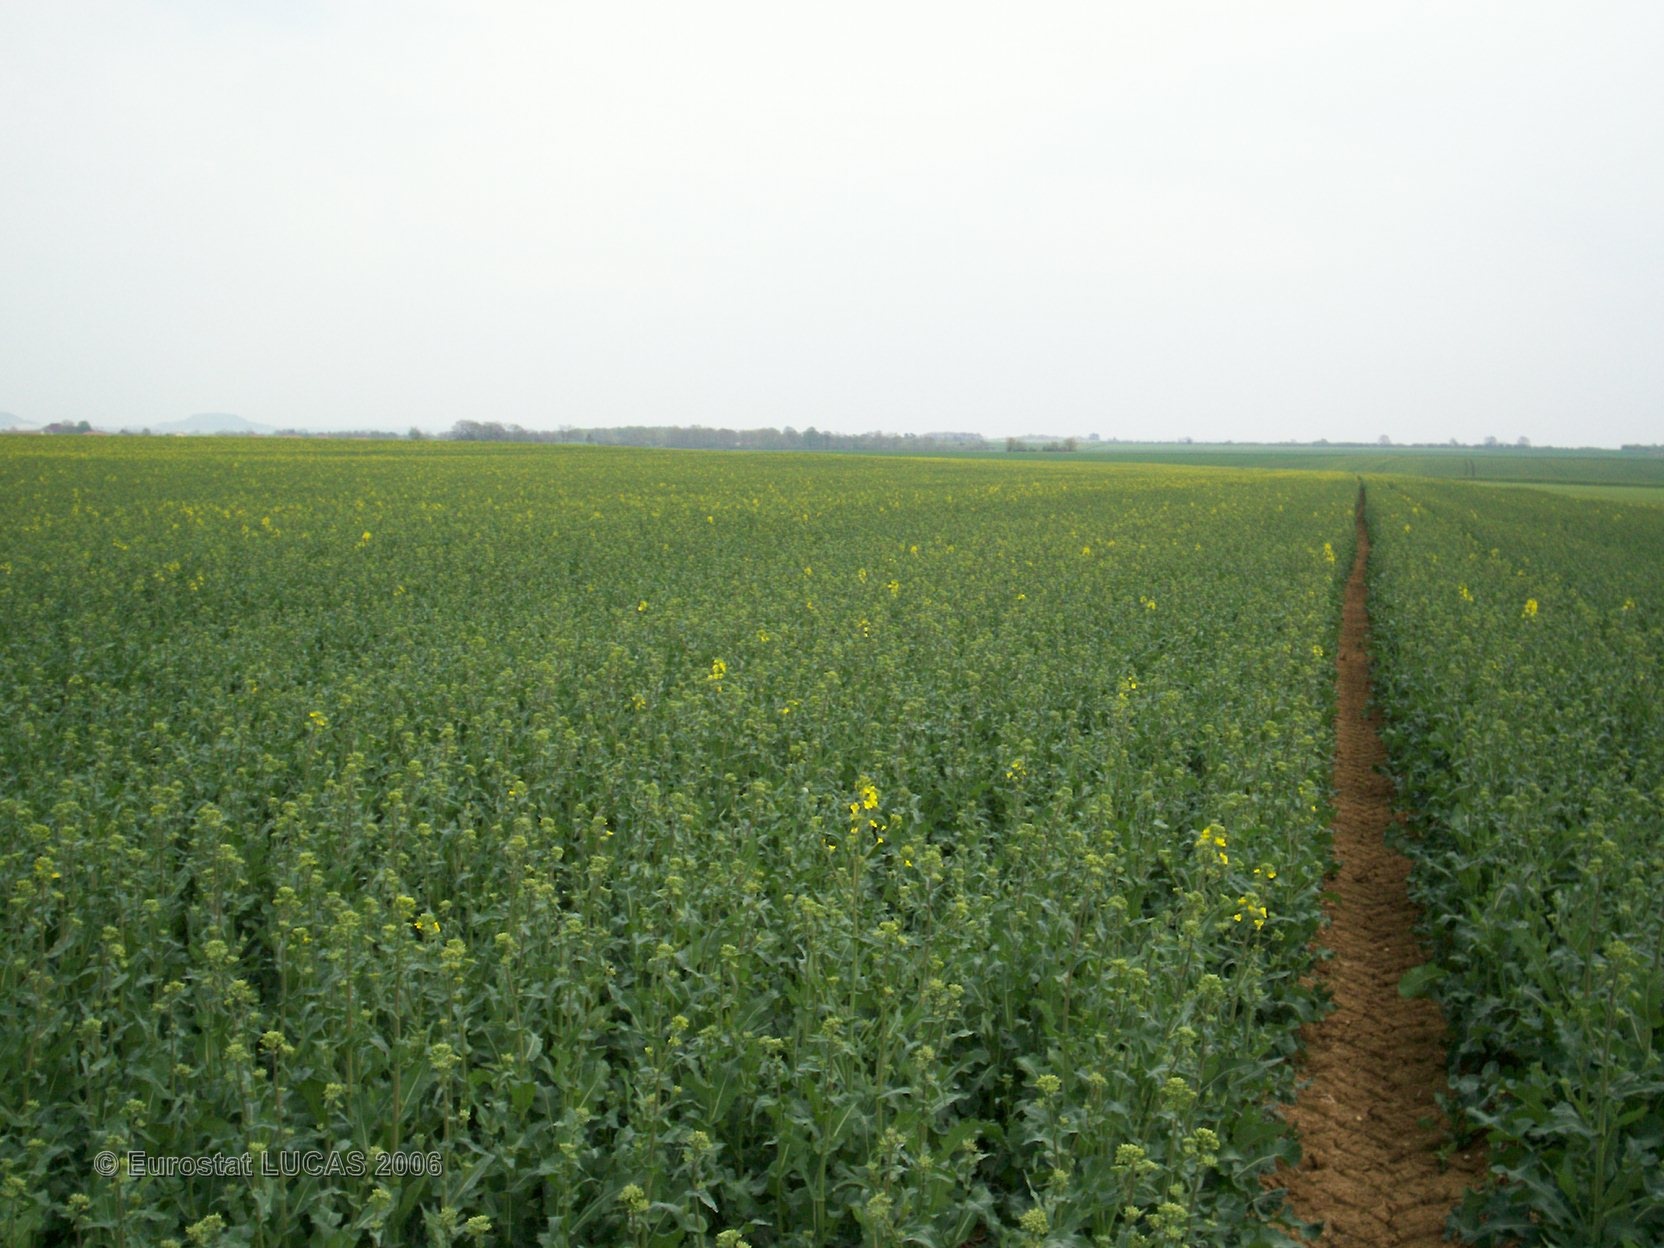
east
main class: Cropland
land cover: Rape and turnip rape
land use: Agriculture (excluding fallow land and kitchen gardens)
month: April
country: FR
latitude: 47.8880
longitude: 4.5017
